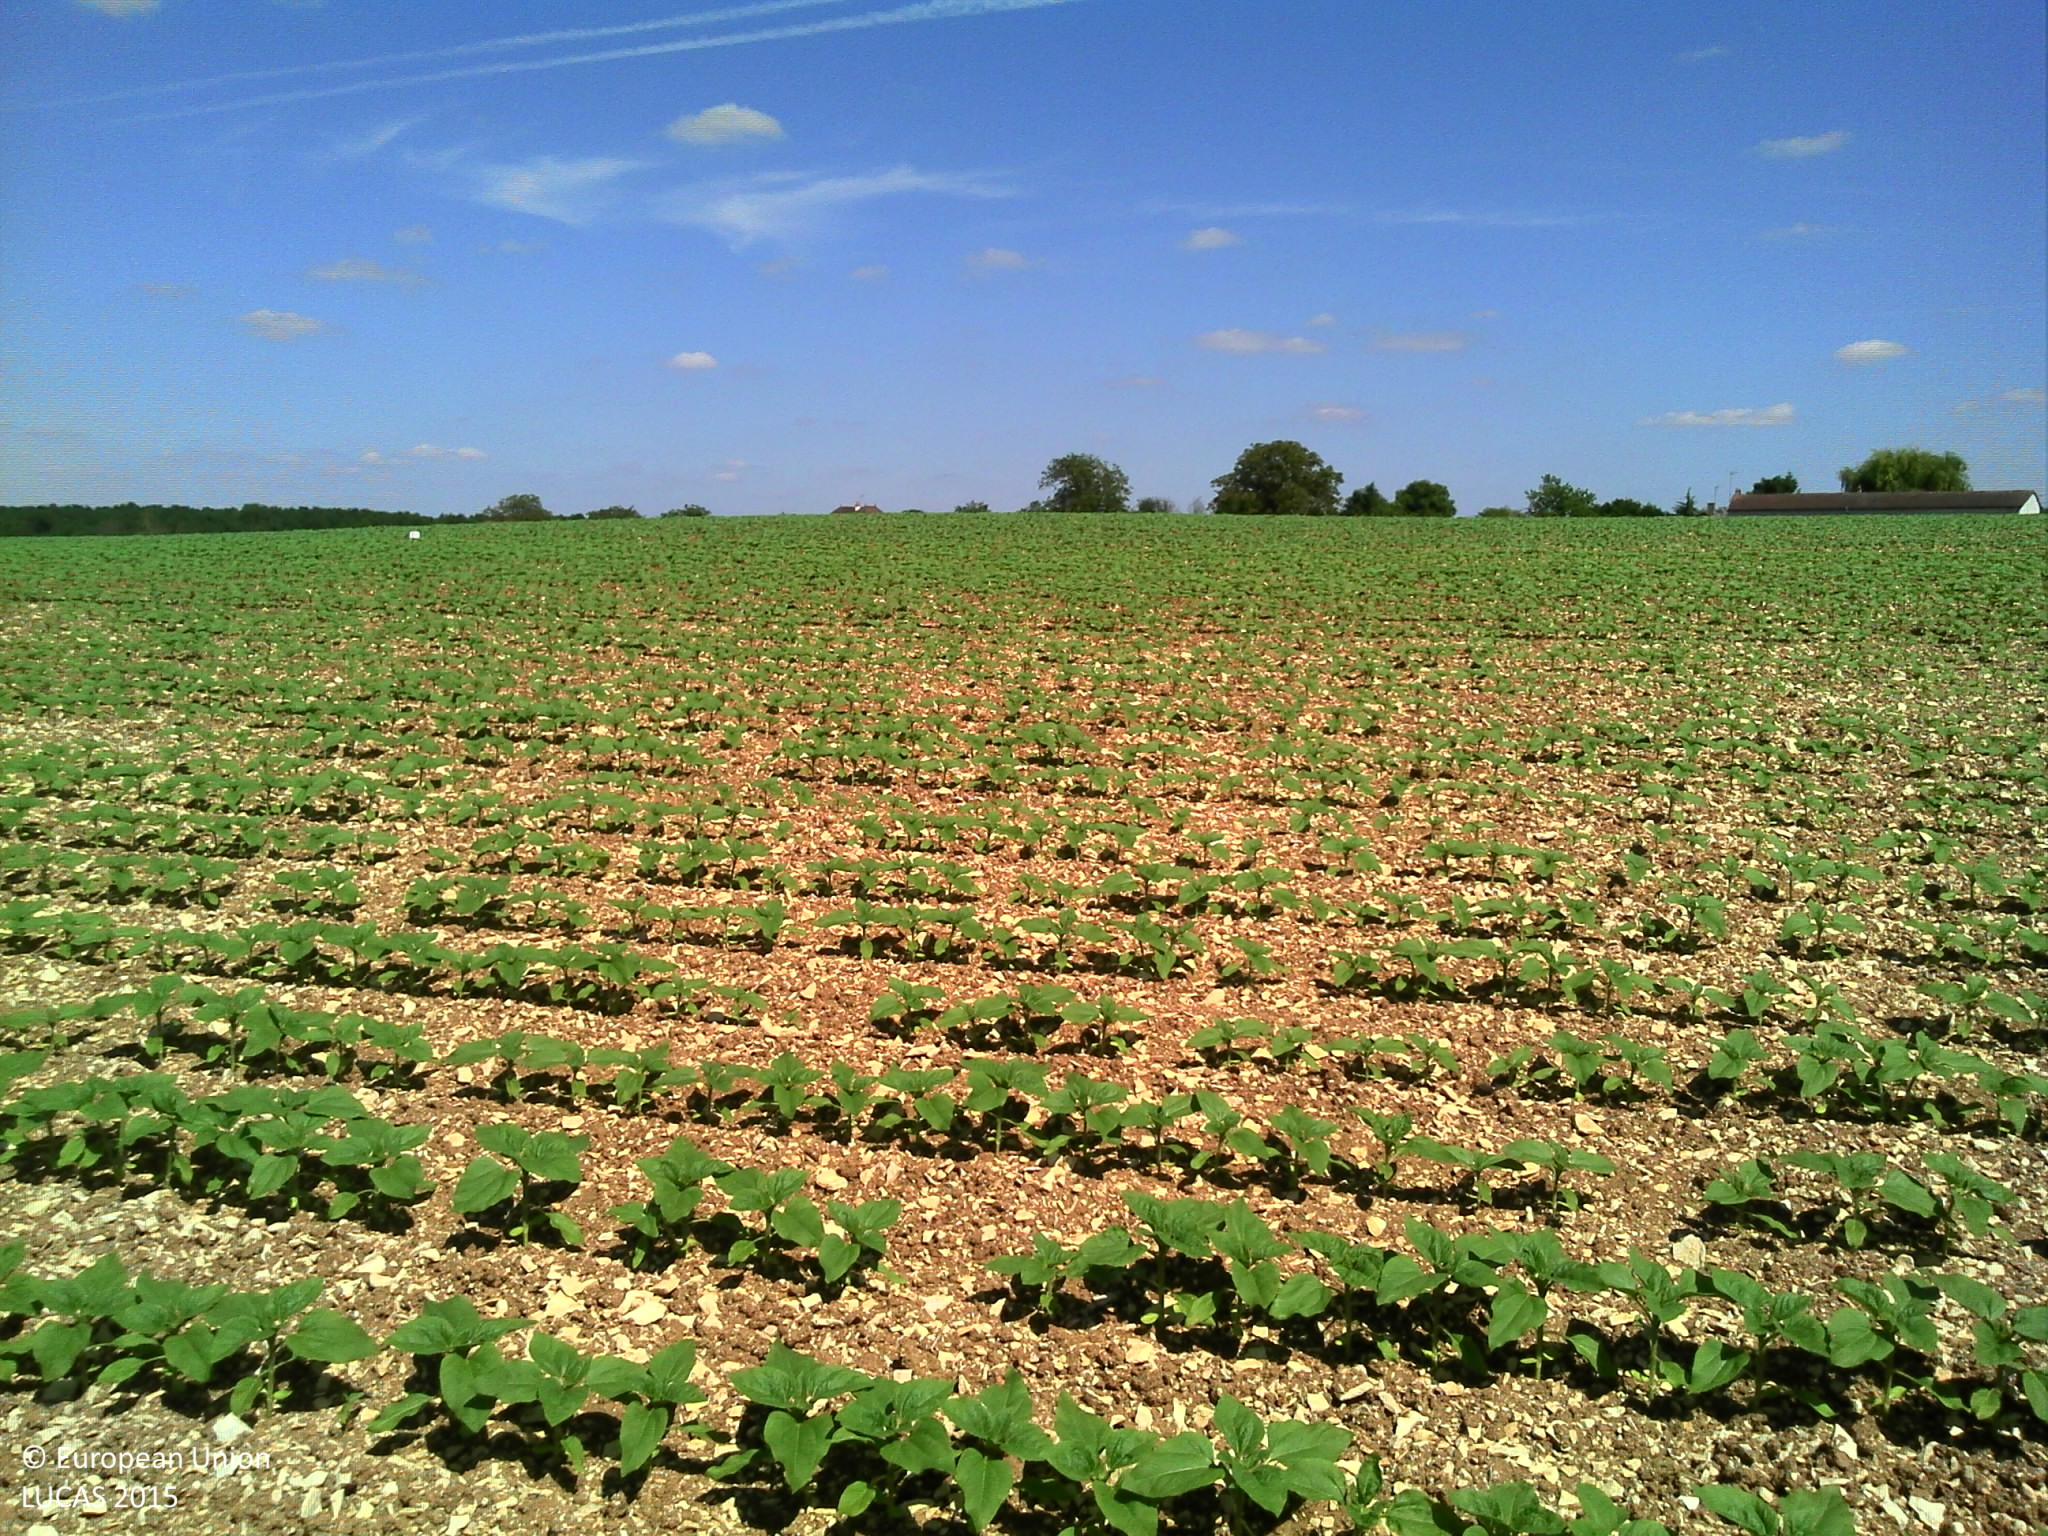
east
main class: Cropland
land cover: Sunflower
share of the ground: 10 - 25 %
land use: Agriculture (excluding fallow land and kitchen gardens)
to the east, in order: Sunflower; Grass margins; Fences; Single bushes/trees; Grassland with sparse tree/shrub cover
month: May
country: FR
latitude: 47.0045
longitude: 0.1793
